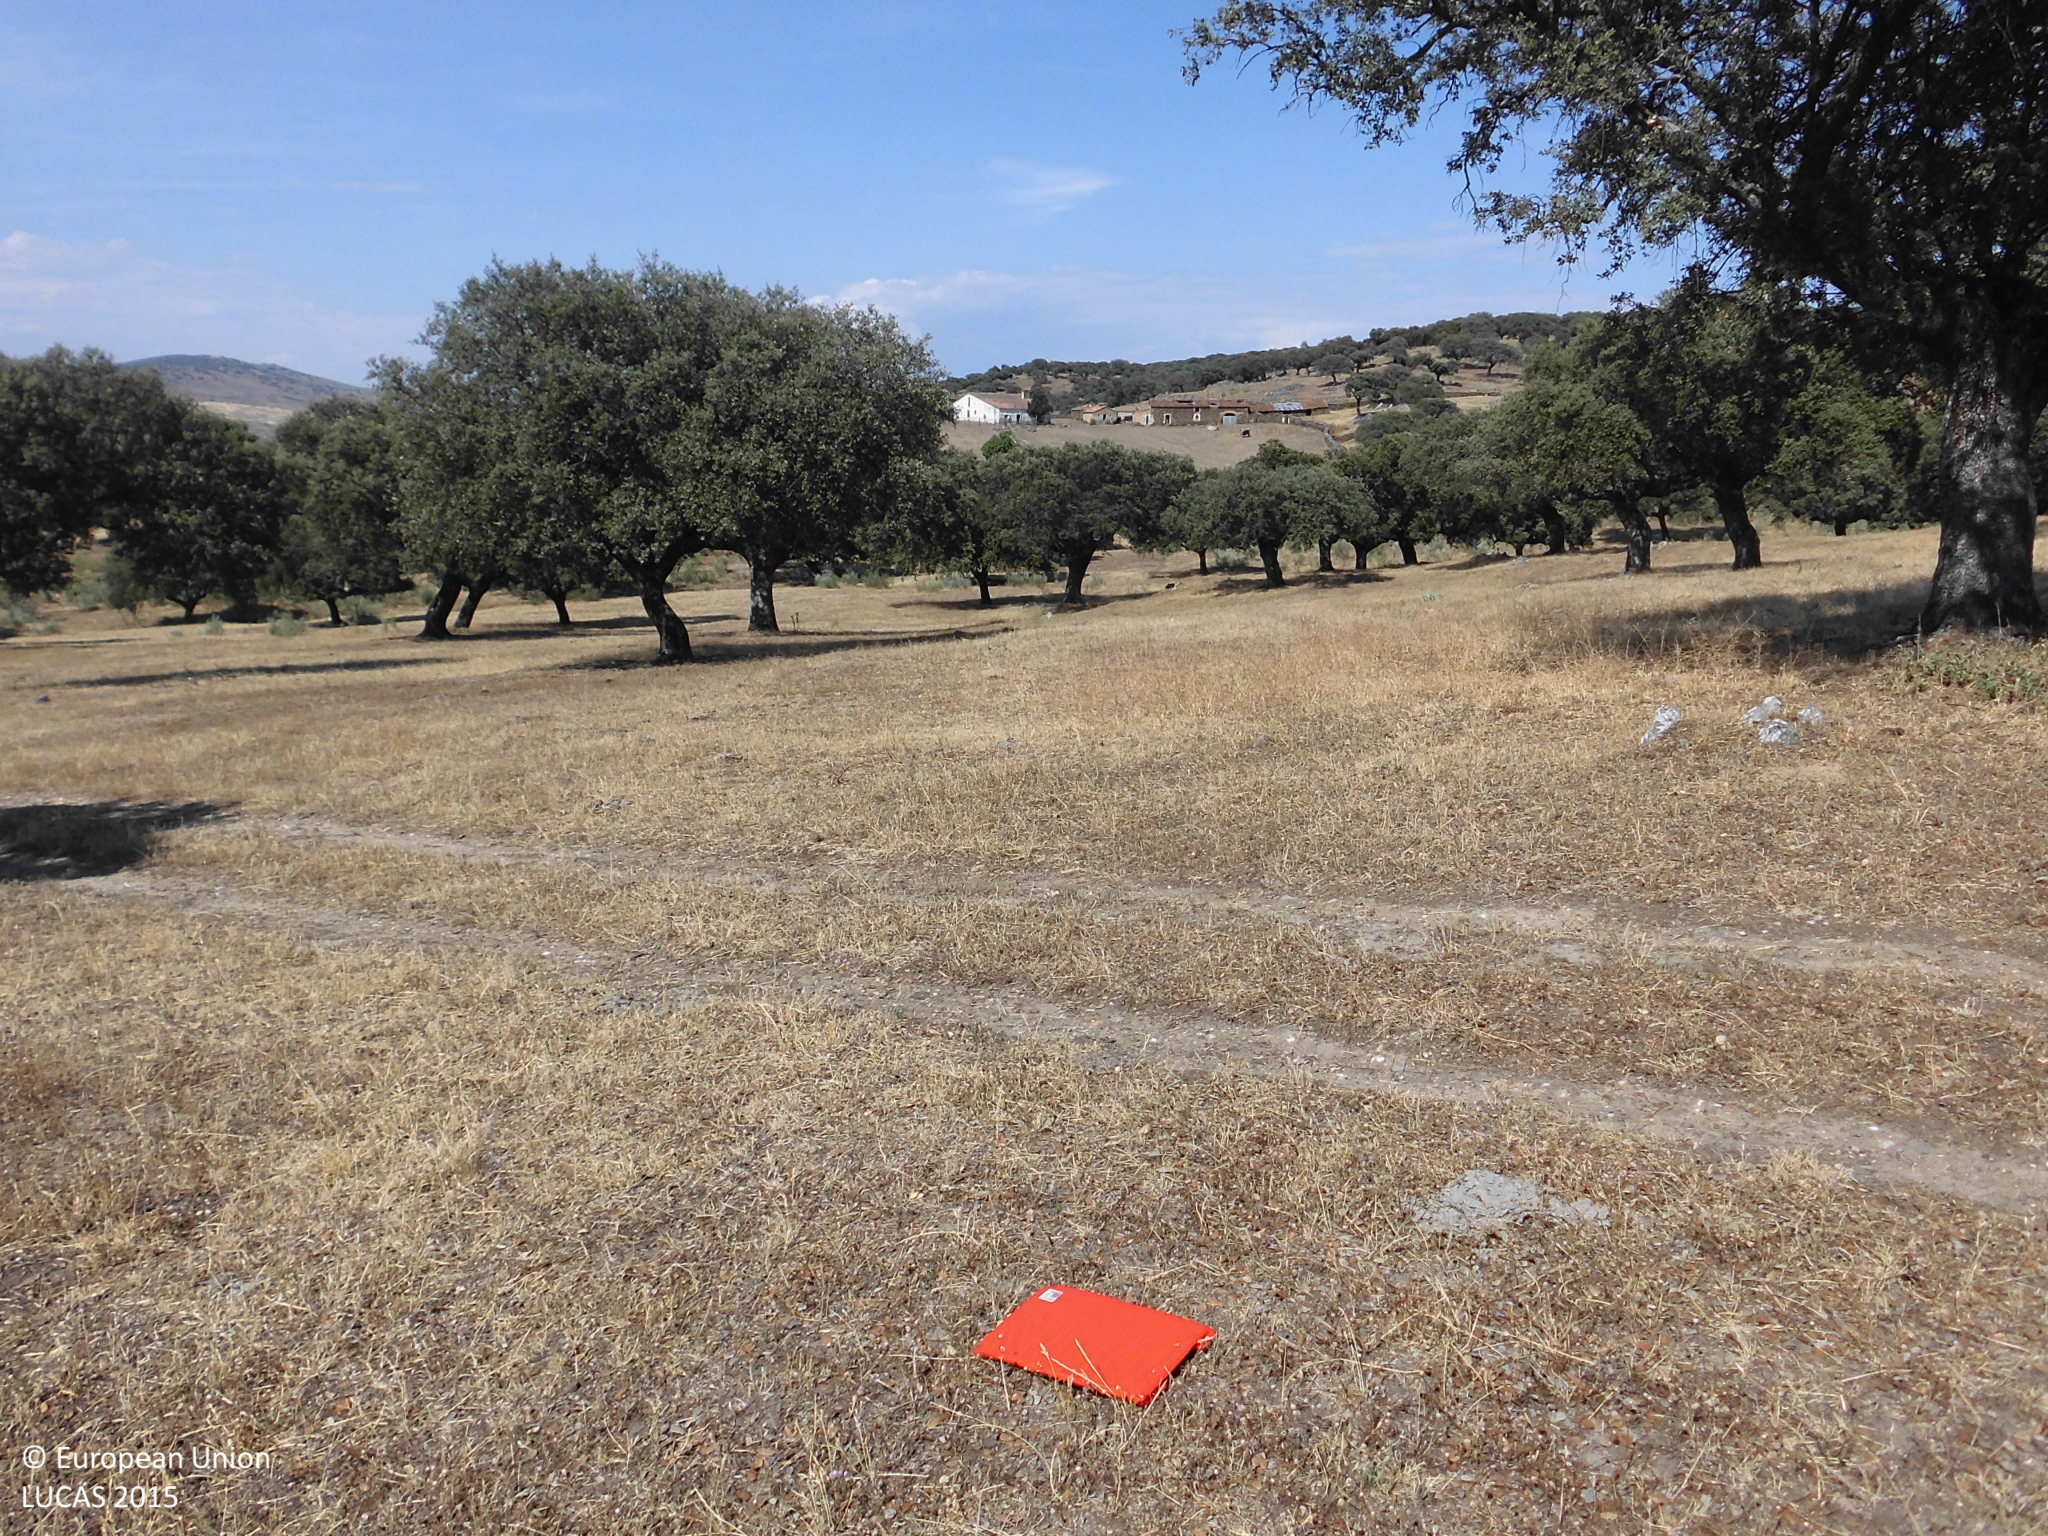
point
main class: Woodland
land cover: Broadleaved woodland
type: broadleaved evergreen forest
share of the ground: 25 - 50 %
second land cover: Grassland without tree/shrub cover
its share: > 75 %
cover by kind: herbaceous plants 70 %, broadleaved forest trees 25 %, unconsolidated bare surface 5 %
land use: Forestry
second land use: Agriculture (excluding fallow land and kitchen gardens)
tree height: > 5 m
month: June
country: ES
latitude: 39.9438
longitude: -6.1880
